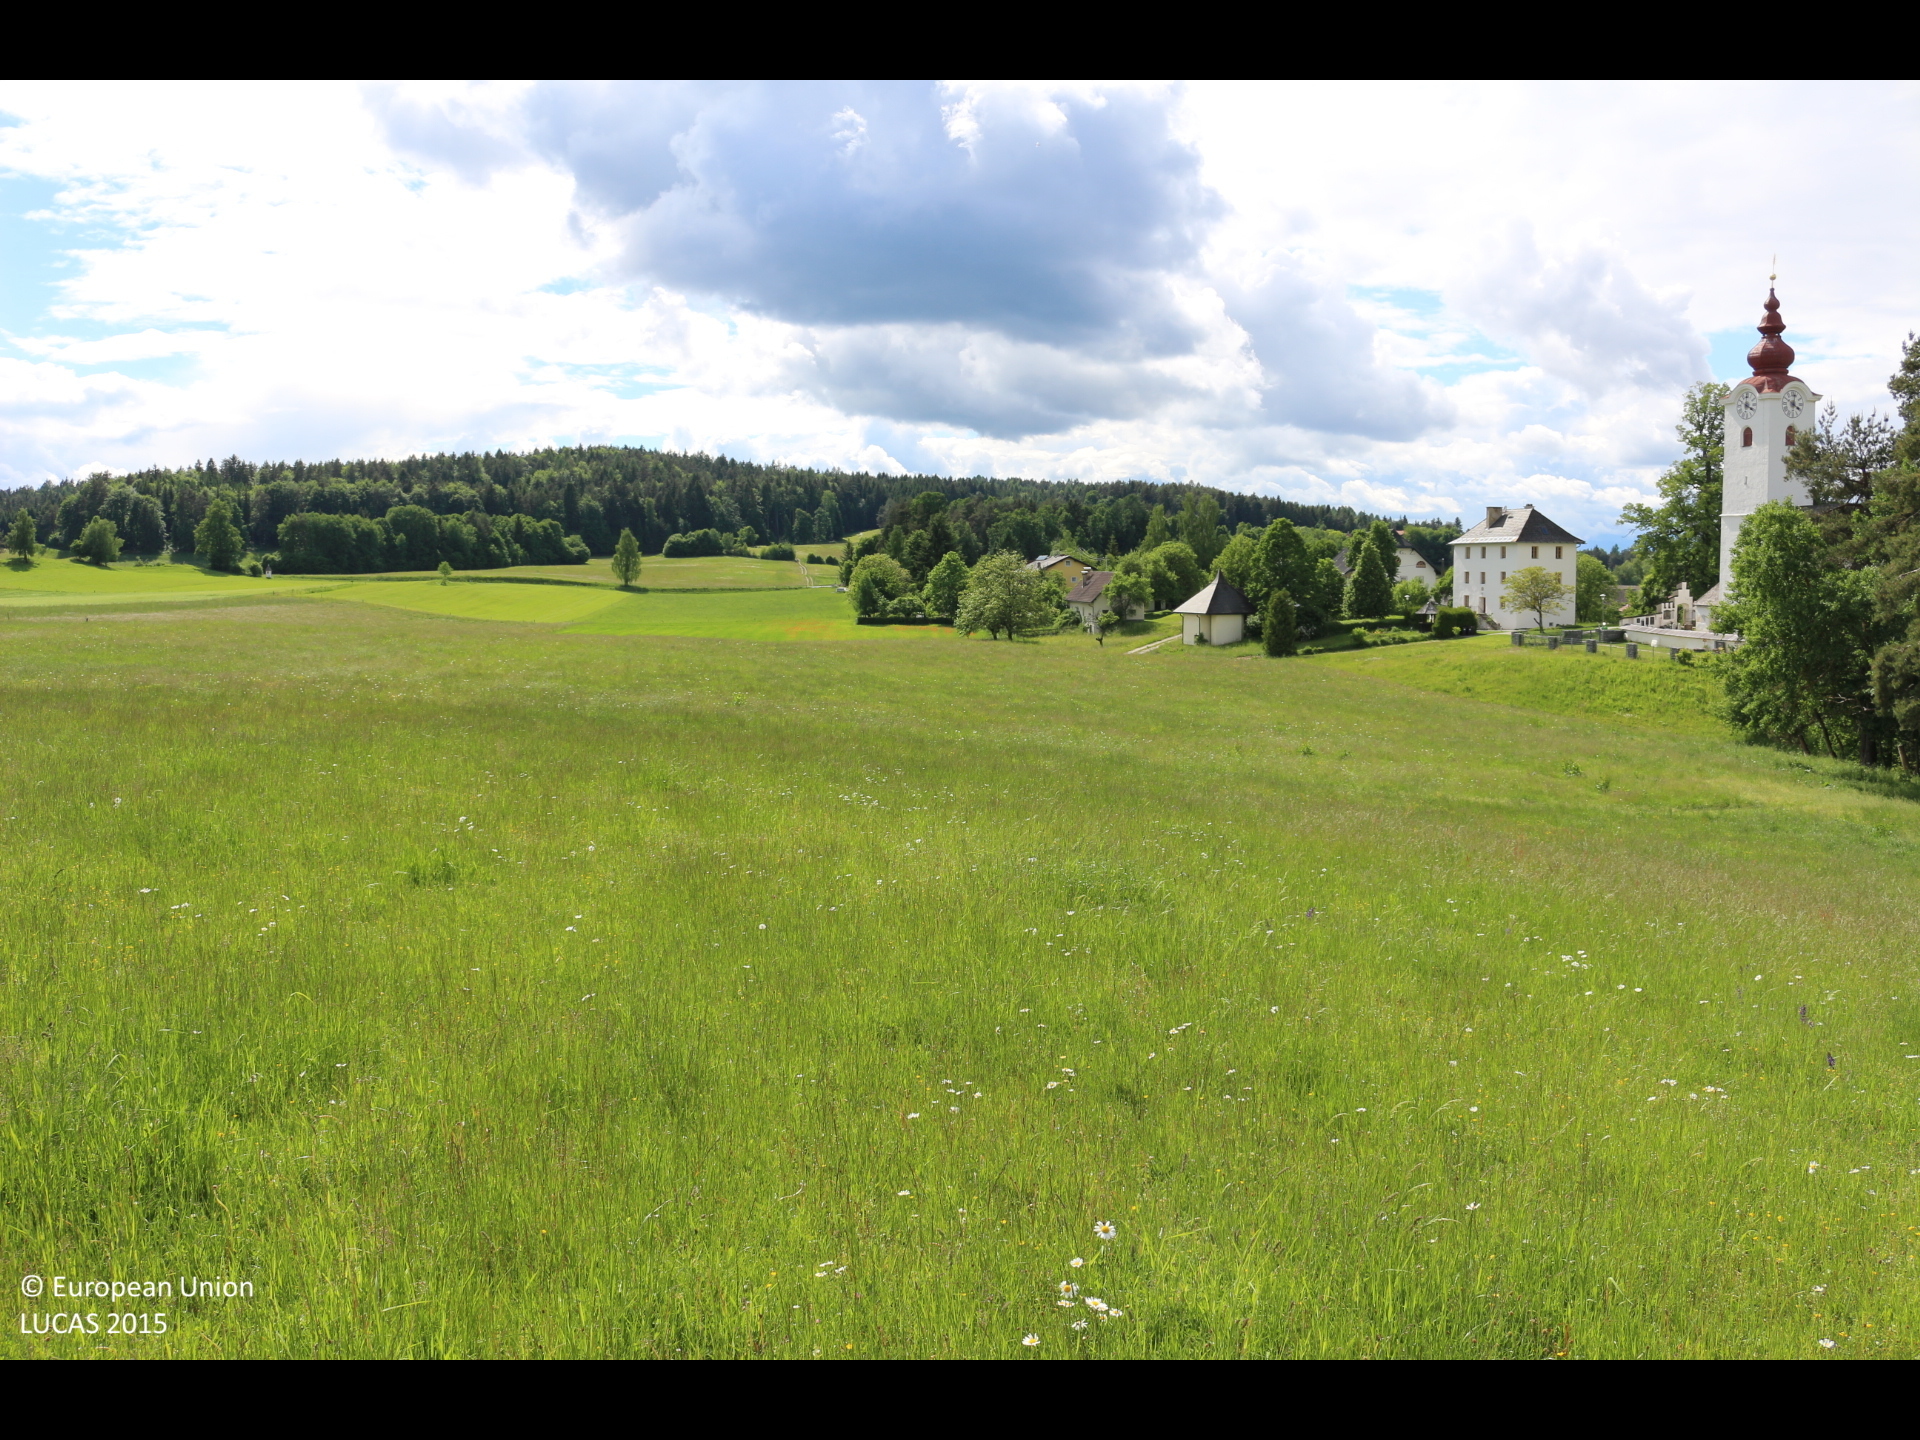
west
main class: Grassland
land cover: Grassland without tree/shrub cover
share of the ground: > 75 %
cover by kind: herbaceous plants 100 %
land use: Agriculture (excluding fallow land and kitchen gardens)
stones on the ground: < 10 %
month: May
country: AT
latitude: 46.5845
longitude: 14.4216
